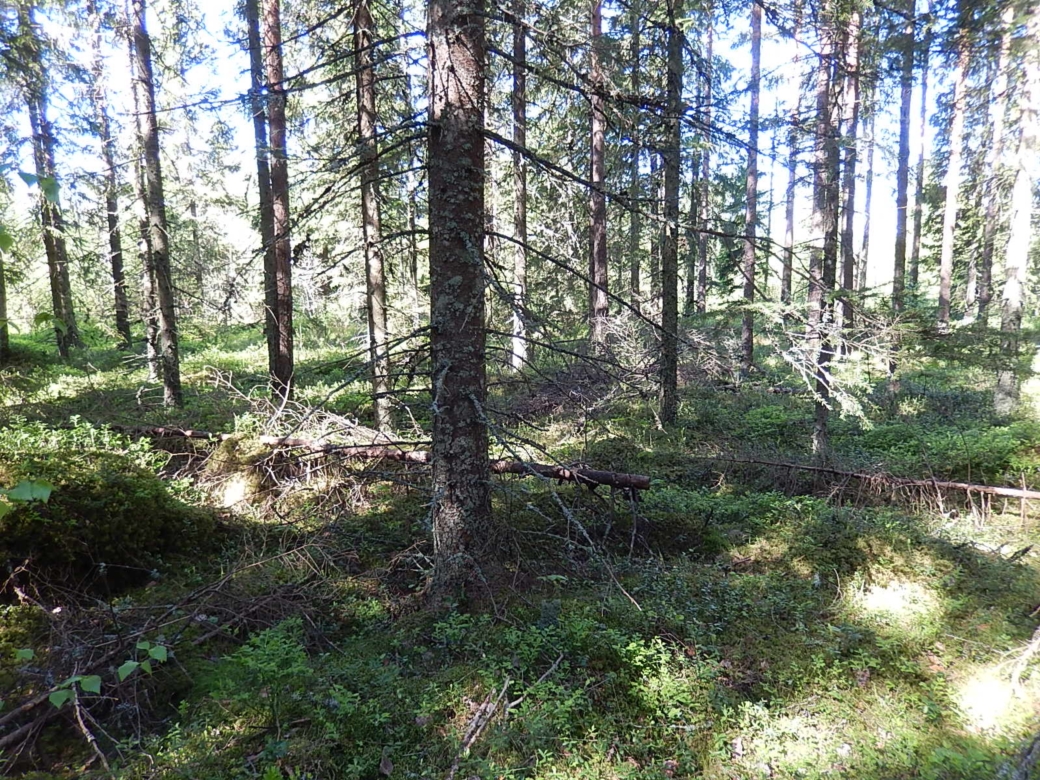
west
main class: Woodland
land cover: Spruce dominated coniferous woodland
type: boreal forest
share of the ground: > 75 %
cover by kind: coniferous forest trees 85 %, shrubs 15 %
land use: Forestry
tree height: > 5 m
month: June
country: FI
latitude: 62.0396
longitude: 21.5374
